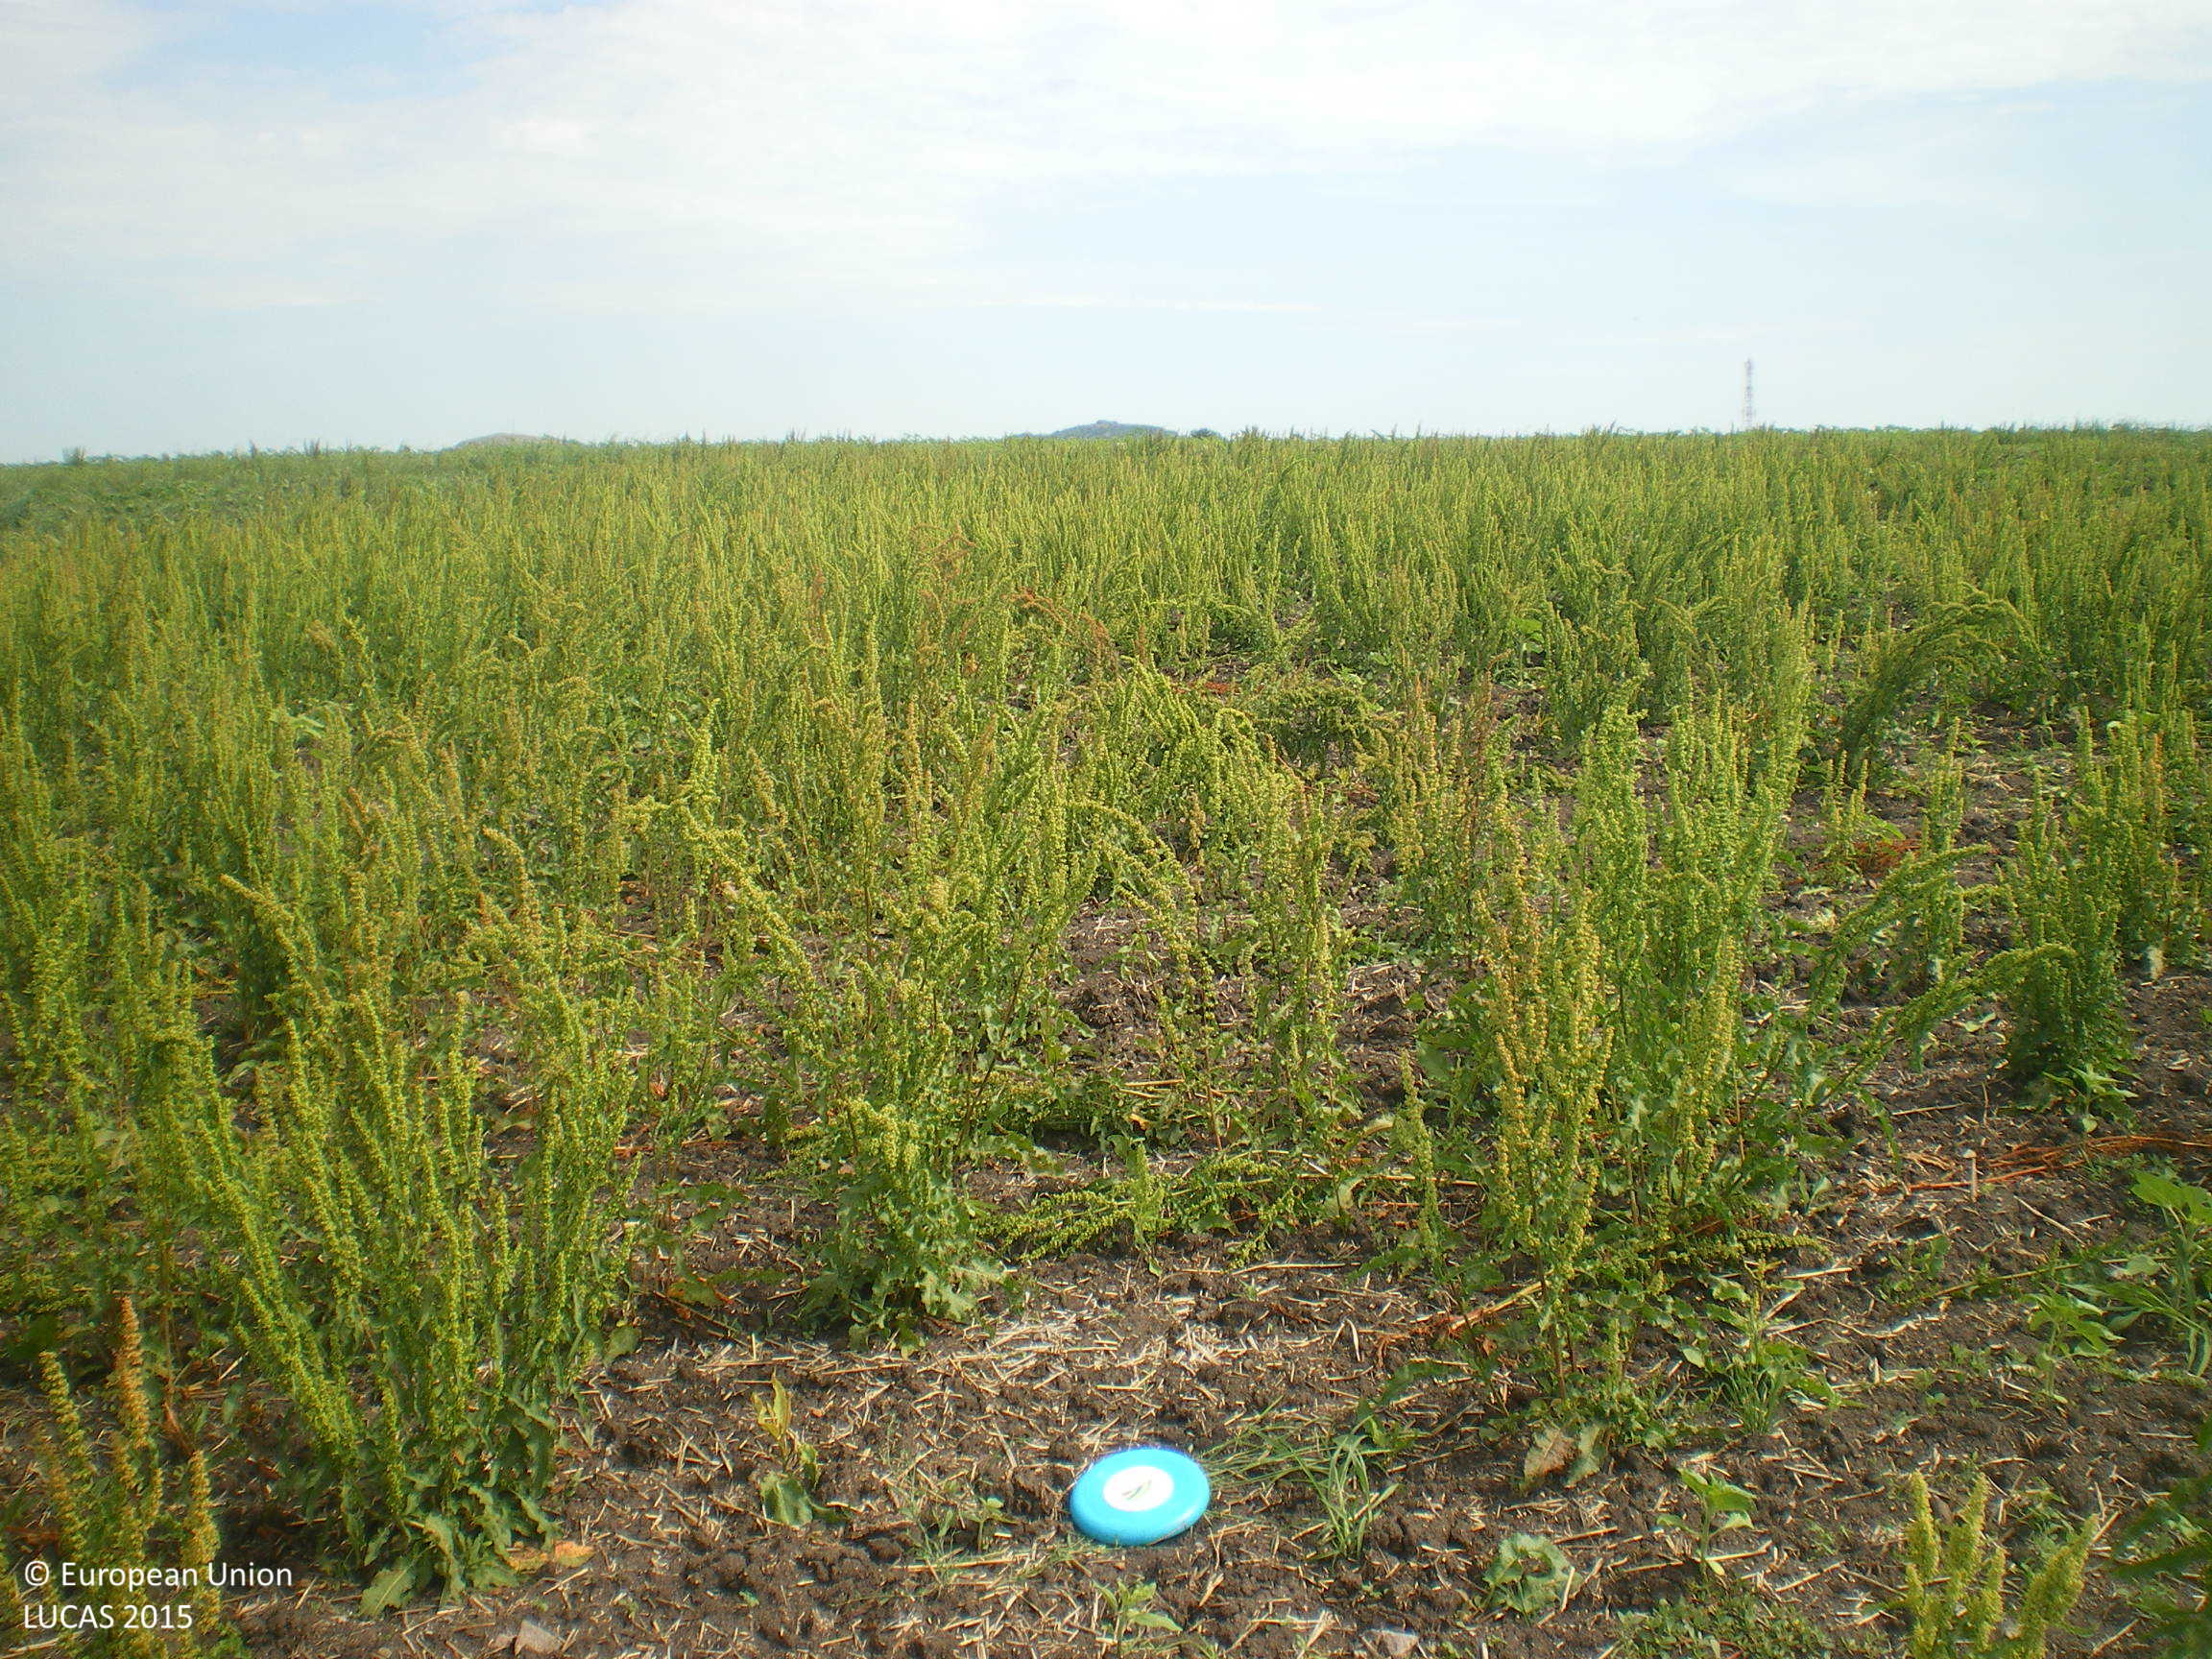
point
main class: Grassland
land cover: Spontaneously vegetated surfaces
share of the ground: > 75 %
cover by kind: herbaceous plants 100 %
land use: Fallow land
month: June
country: BG
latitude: 42.0383
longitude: 25.3919
